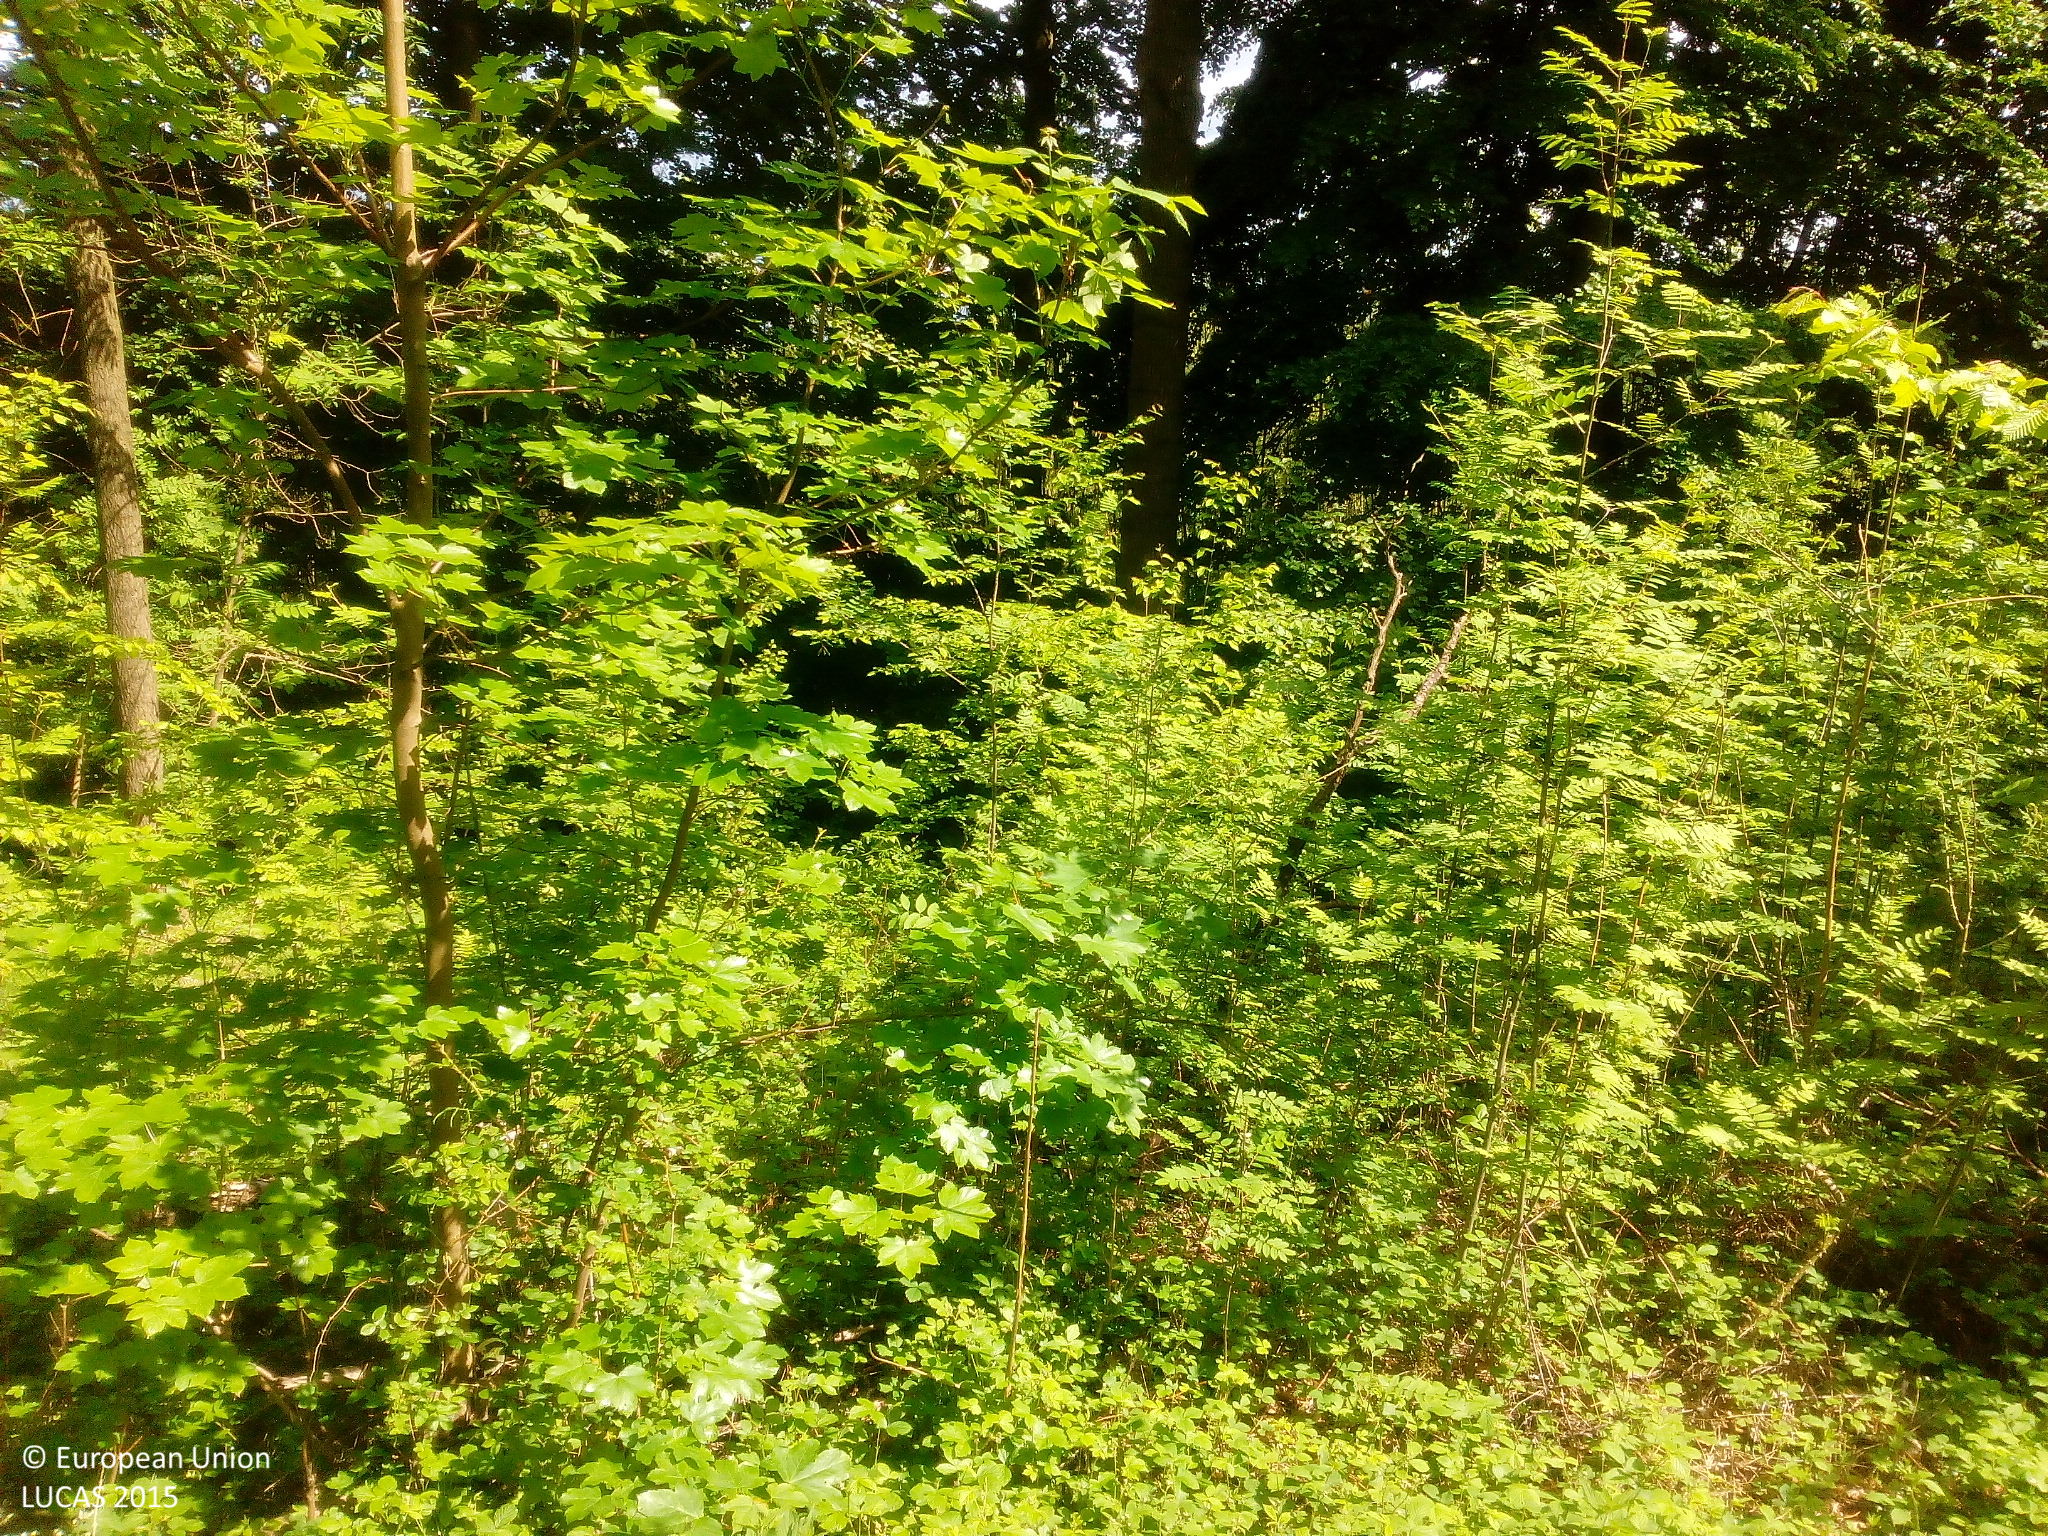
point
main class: Woodland
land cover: Broadleaved woodland
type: beech forest
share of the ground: > 75 %
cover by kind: broadleaved forest trees 100 %
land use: Forestry
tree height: > 5 m
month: May
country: DE
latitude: 51.3511
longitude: 9.3541
